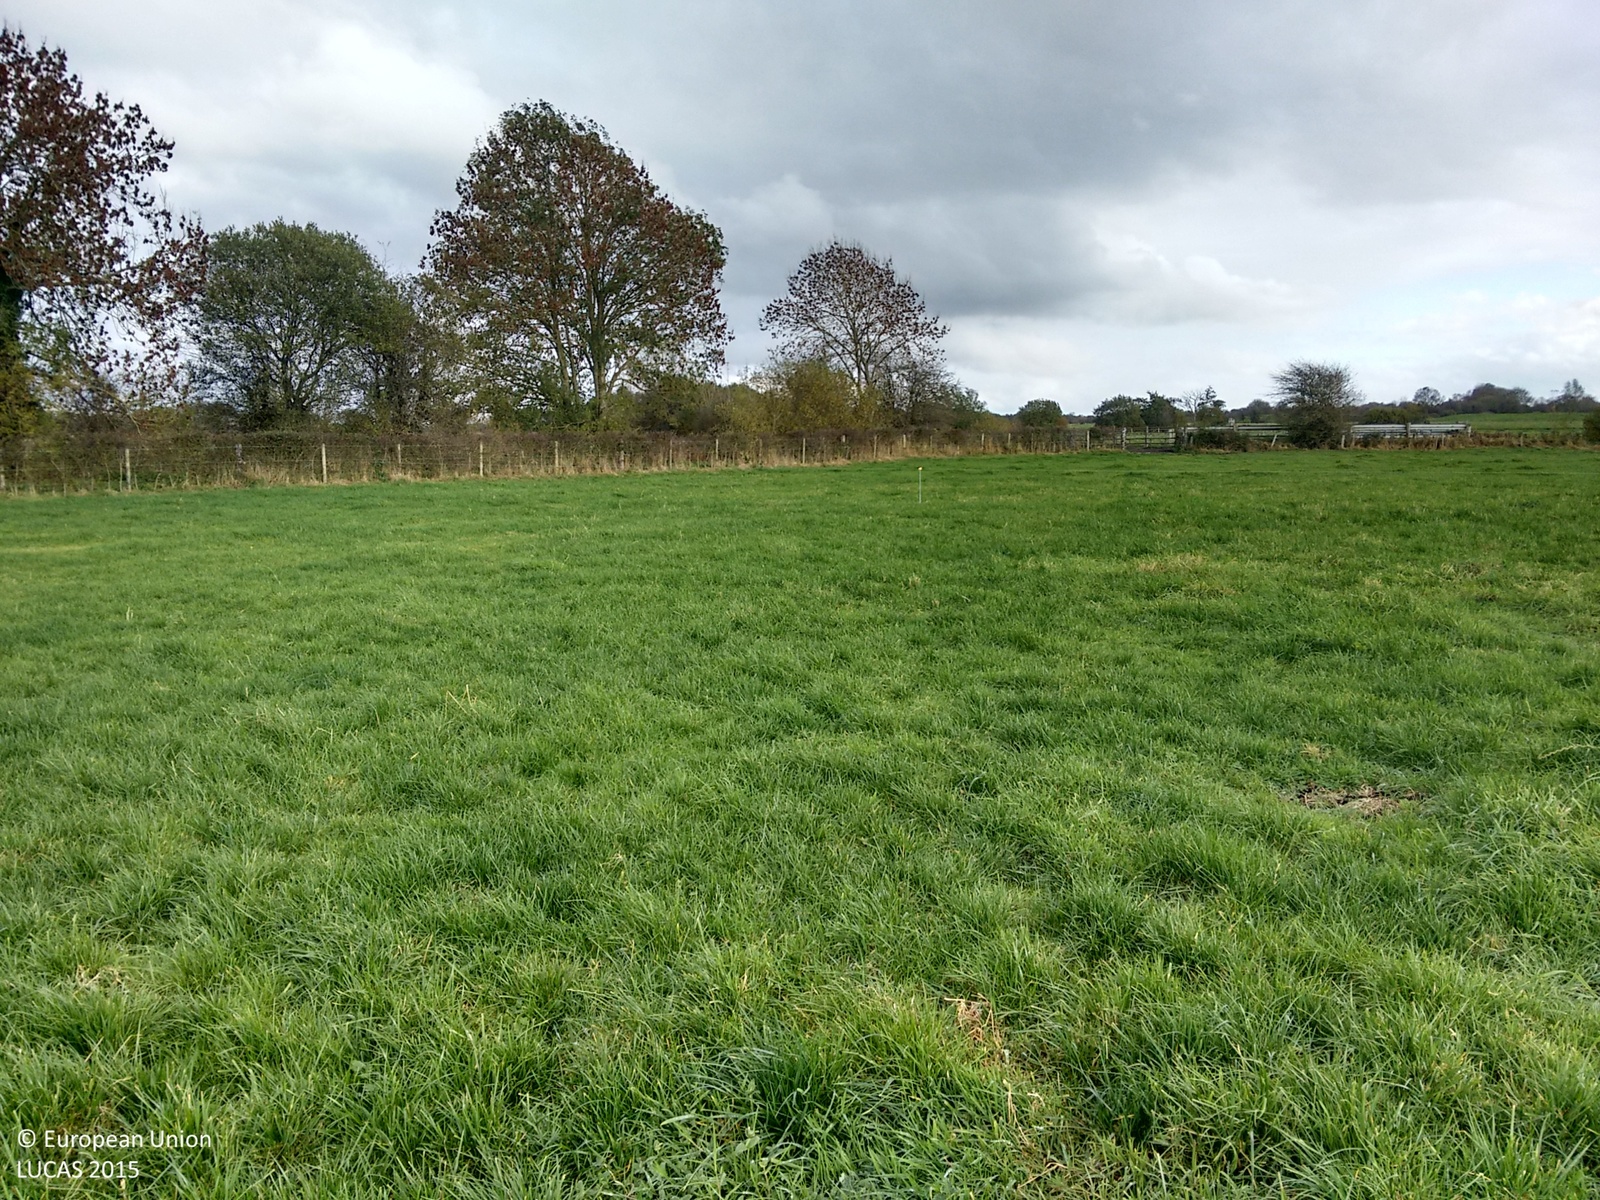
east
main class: Grassland
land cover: Grassland without tree/shrub cover
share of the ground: > 75 %
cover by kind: herbaceous plants 100 %
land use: Agriculture (excluding fallow land and kitchen gardens)
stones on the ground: < 10 %
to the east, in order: Grassland without tree/shrub cover; Fences; Grassland without tree/shrub cover; Fences; Managed hedges; Tracks; Shruby margins; Ditches and canals; Broadleaved woodland; Fences; Grassland without tree/shrub cover; Fences; Shruby margins; Rivers and streams; Shruby margins; Fences; Grassland without tree/shrub cover; Fences; Ditches and canals; Fences; Grassland without tree/shrub cover
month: October
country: IE
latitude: 53.2725
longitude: -7.7564
